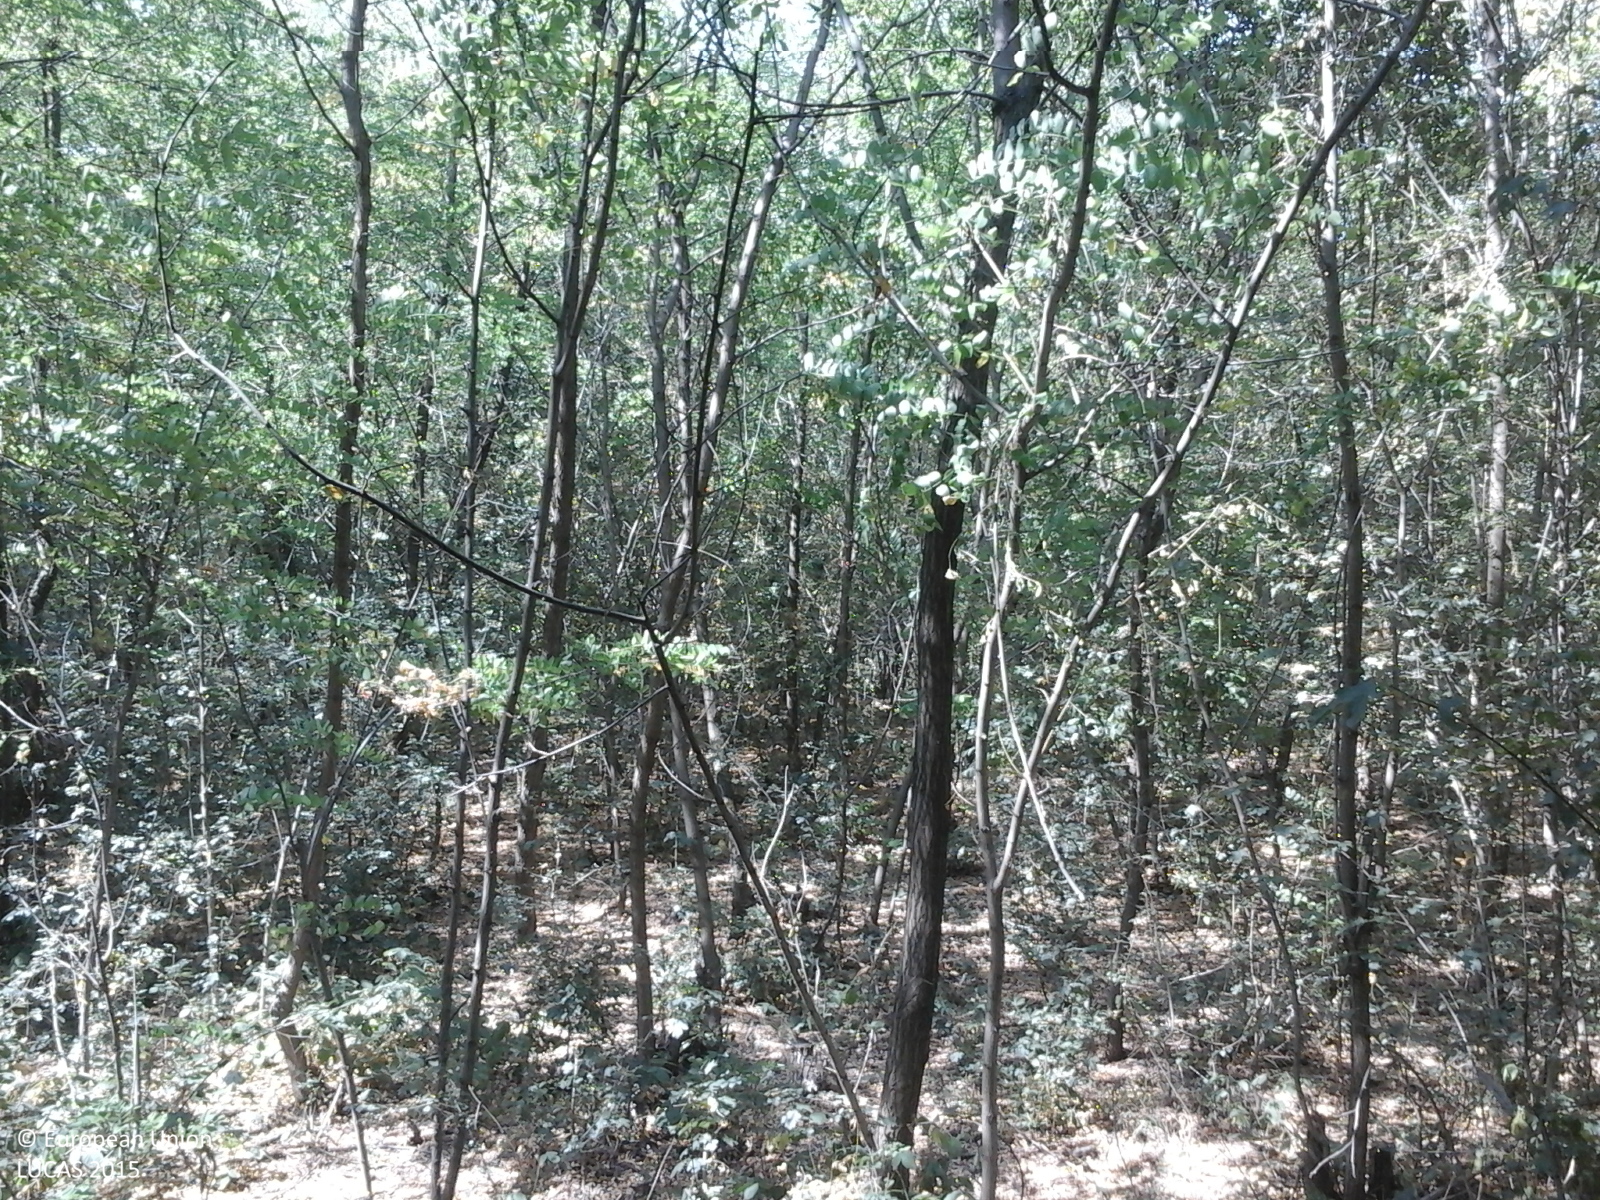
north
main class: Woodland
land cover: Broadleaved woodland
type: exotic forest
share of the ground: > 75 %
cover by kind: broadleaved forest trees 100 %
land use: Forestry
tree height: > 5 m
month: July
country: RO
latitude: 46.3026
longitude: 27.3331
